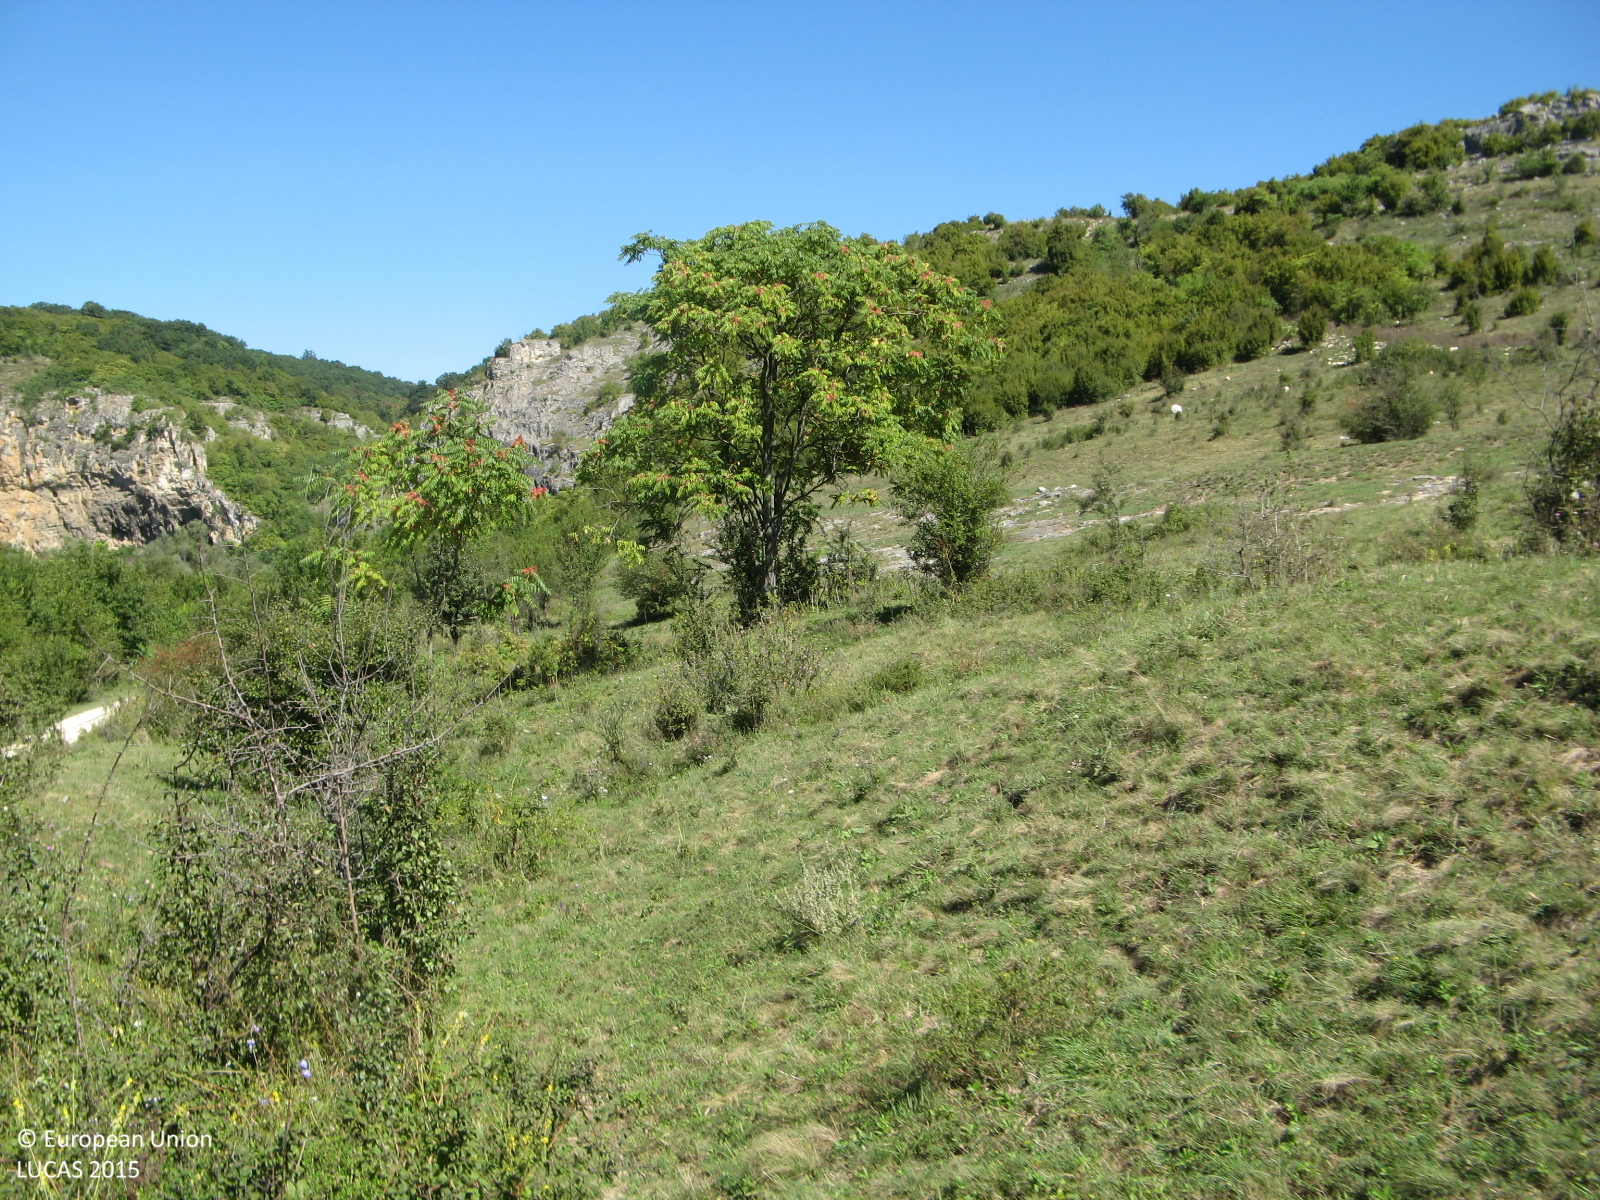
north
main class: Grassland
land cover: Grassland with sparse tree/shrub cover
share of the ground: > 75 %
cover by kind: herbaceous plants 90 %, broadleaved forest trees 5 %, shrubs 5 %
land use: Agriculture (excluding fallow land and kitchen gardens)
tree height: < 5 m
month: September
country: BG
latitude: 43.6560
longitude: 26.0792
